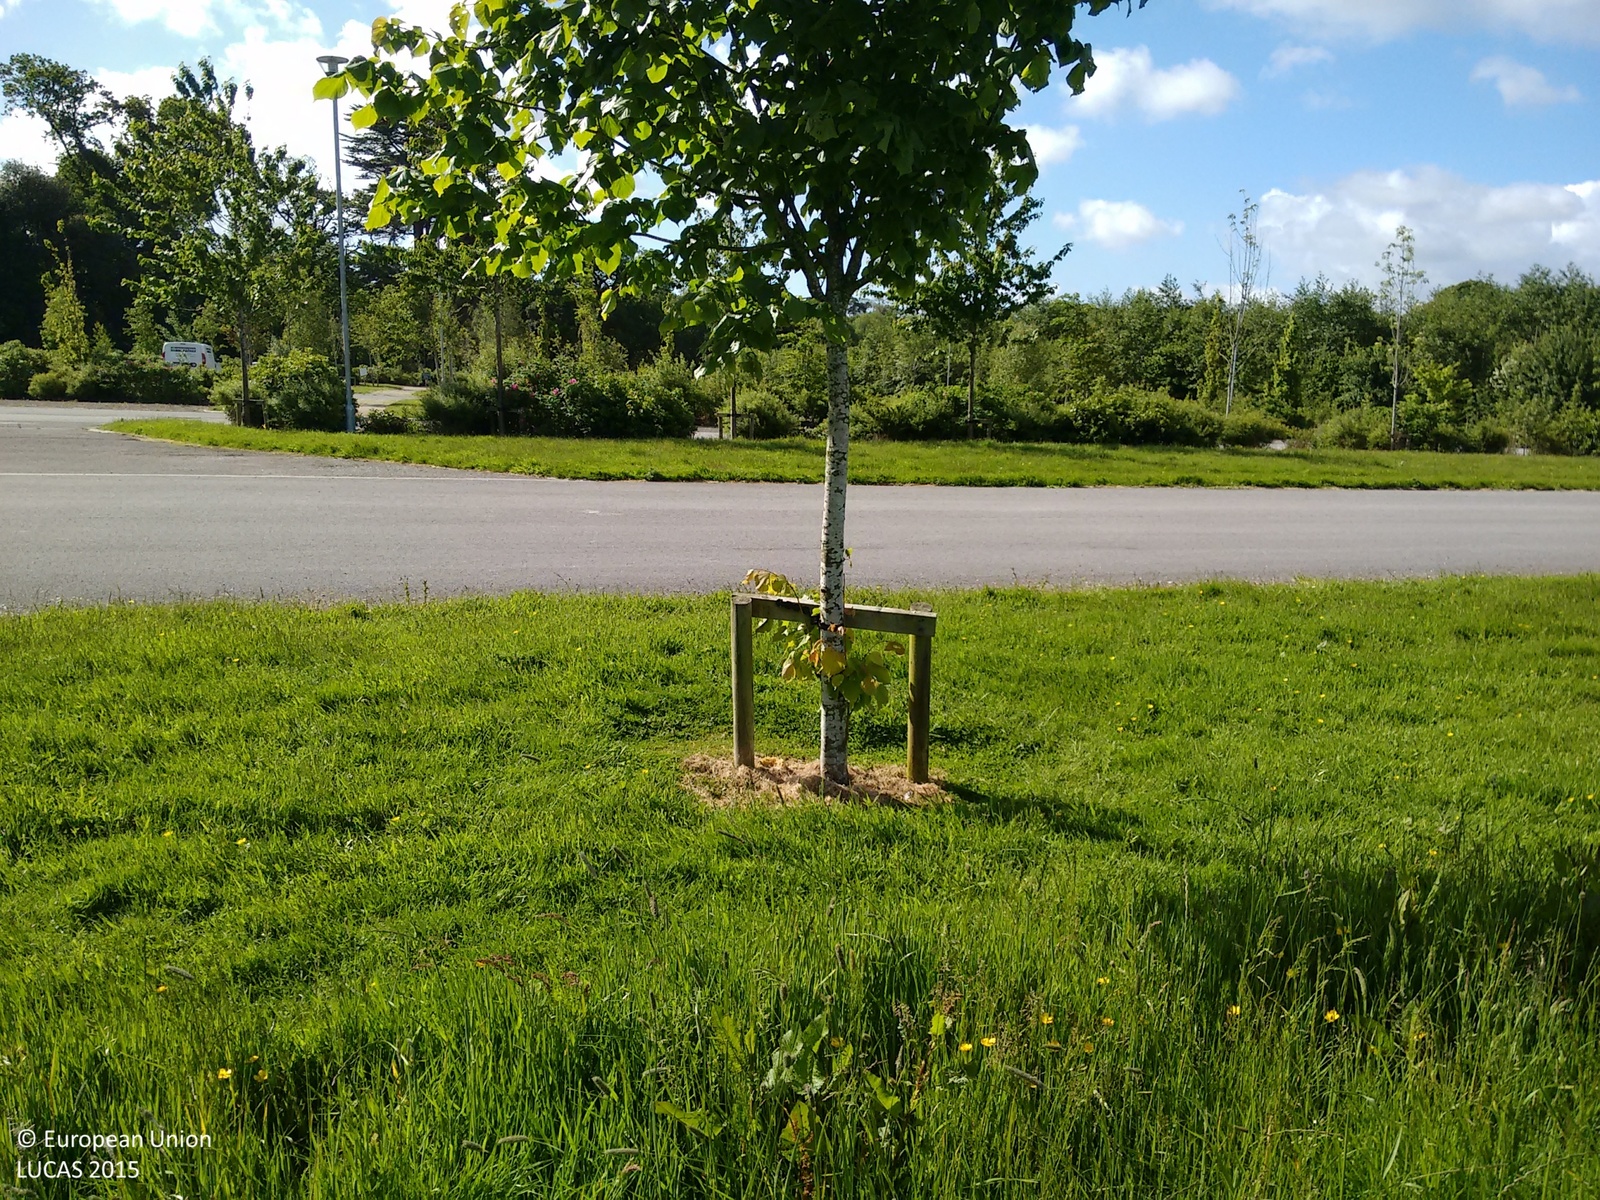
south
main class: Grassland
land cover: Grassland without tree/shrub cover
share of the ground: > 75 %
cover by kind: herbaceous plants 70 %, consolidated bare surface 30 %
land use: Agriculture (excluding fallow land and kitchen gardens)
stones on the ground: < 10 %
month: June
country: IE
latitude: 51.8954
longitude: -8.3083
